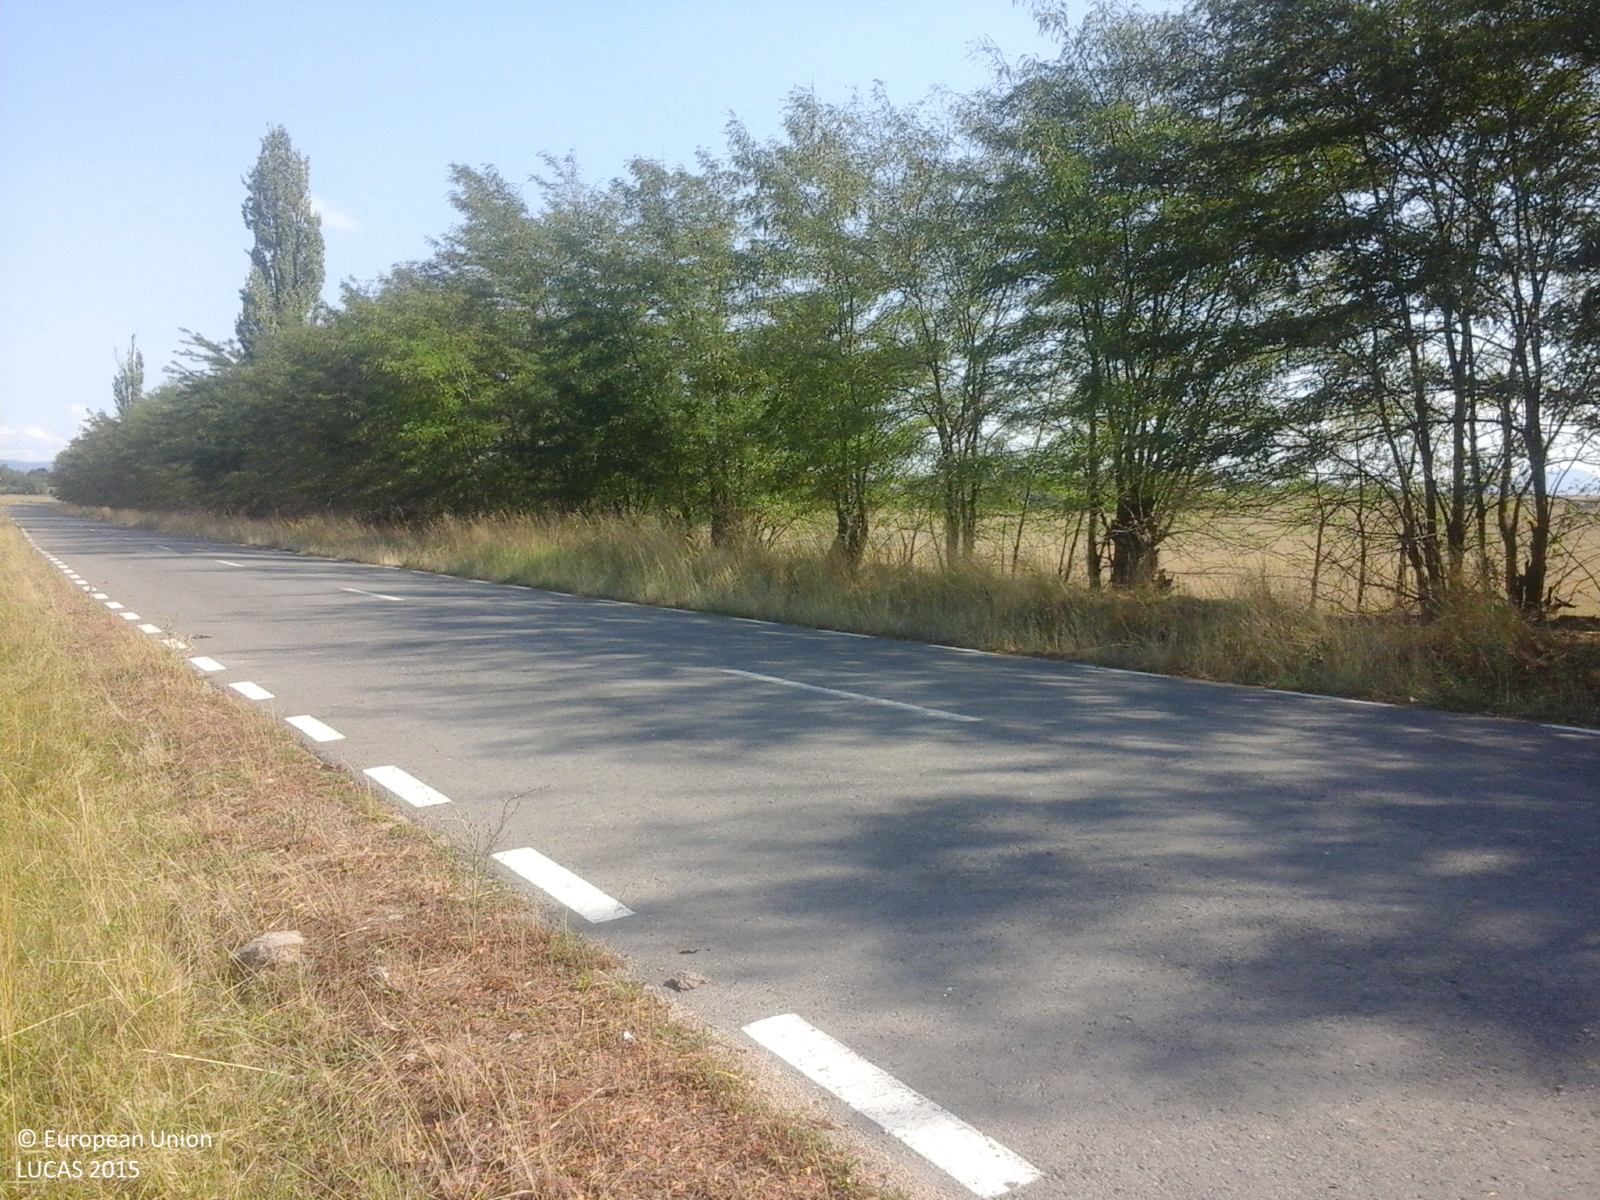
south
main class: Grassland
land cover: Grassland without tree/shrub cover
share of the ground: > 75 %
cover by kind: herbaceous plants 100 %
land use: Agriculture (excluding fallow land and kitchen gardens)
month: August
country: RO
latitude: 45.3722
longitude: 21.4333
